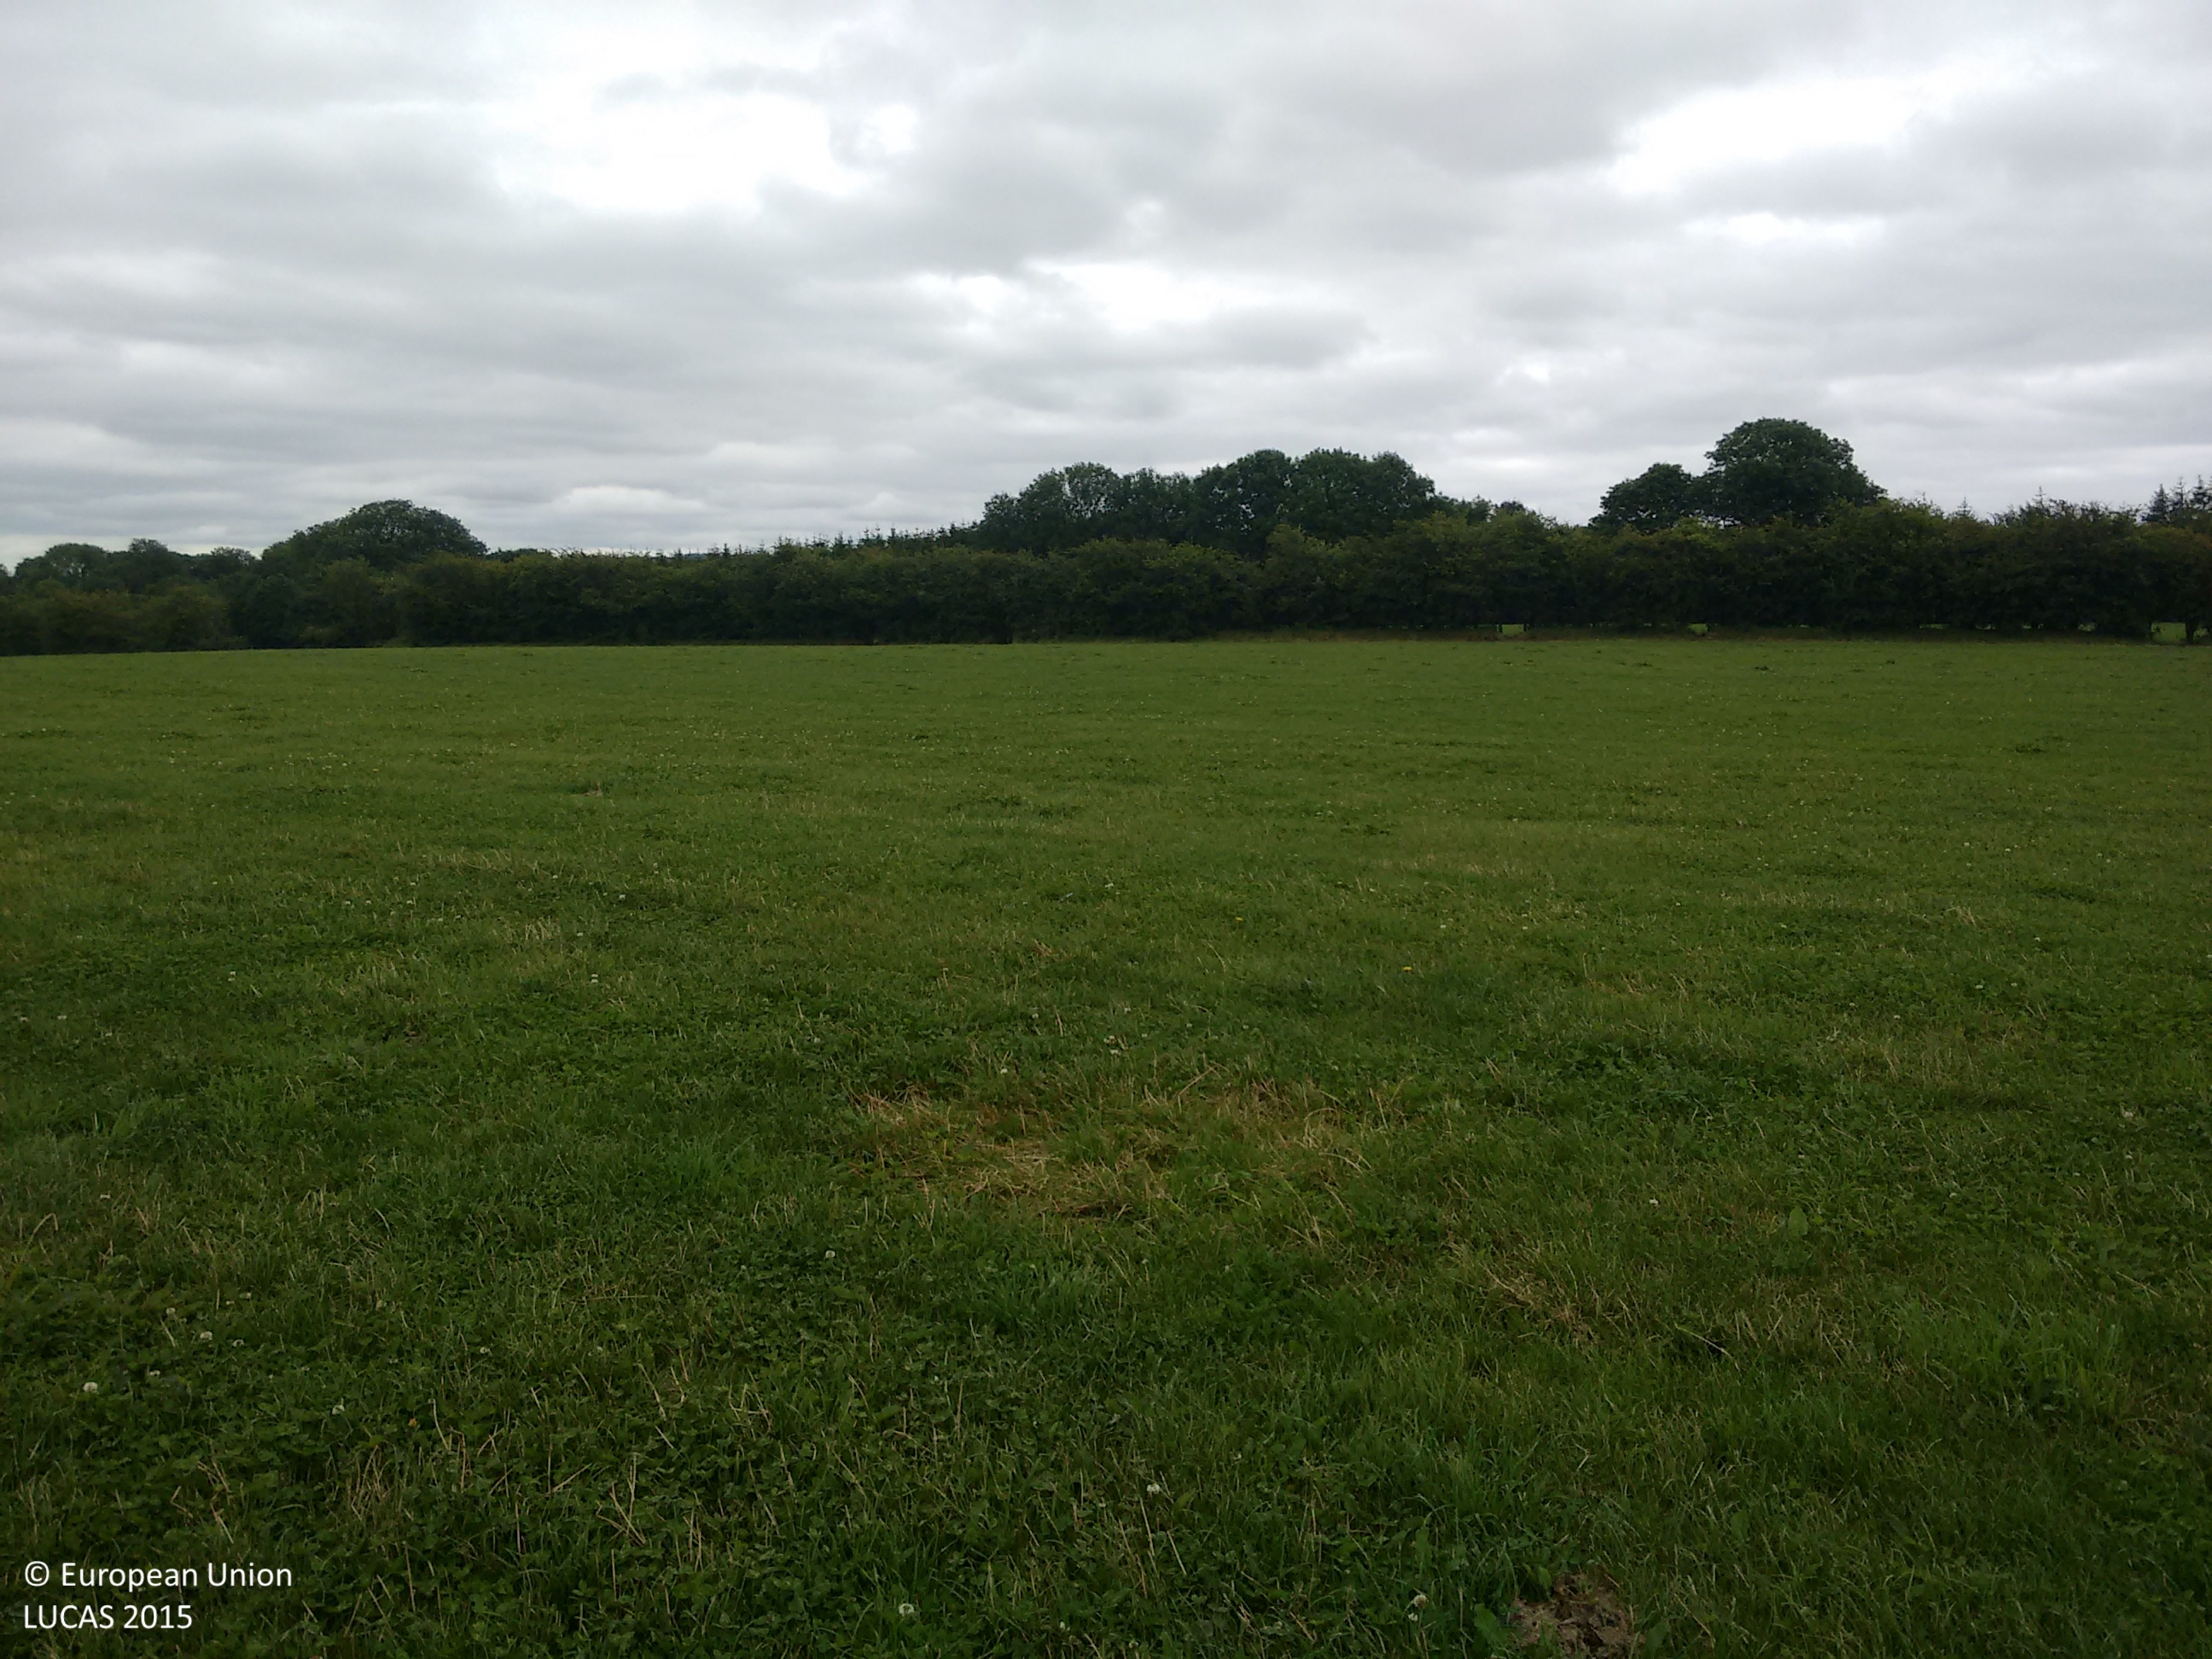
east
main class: Grassland
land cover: Grassland without tree/shrub cover
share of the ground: > 75 %
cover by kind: herbaceous plants 100 %
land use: Agriculture (excluding fallow land and kitchen gardens)
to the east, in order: Grassland without tree/shrub cover; Abandoned hedges; Grassland without tree/shrub cover; Fences; Broadleaved woodland; Spruce dominated coniferous woodland
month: July
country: IE
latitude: 53.7096
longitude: -8.1640
